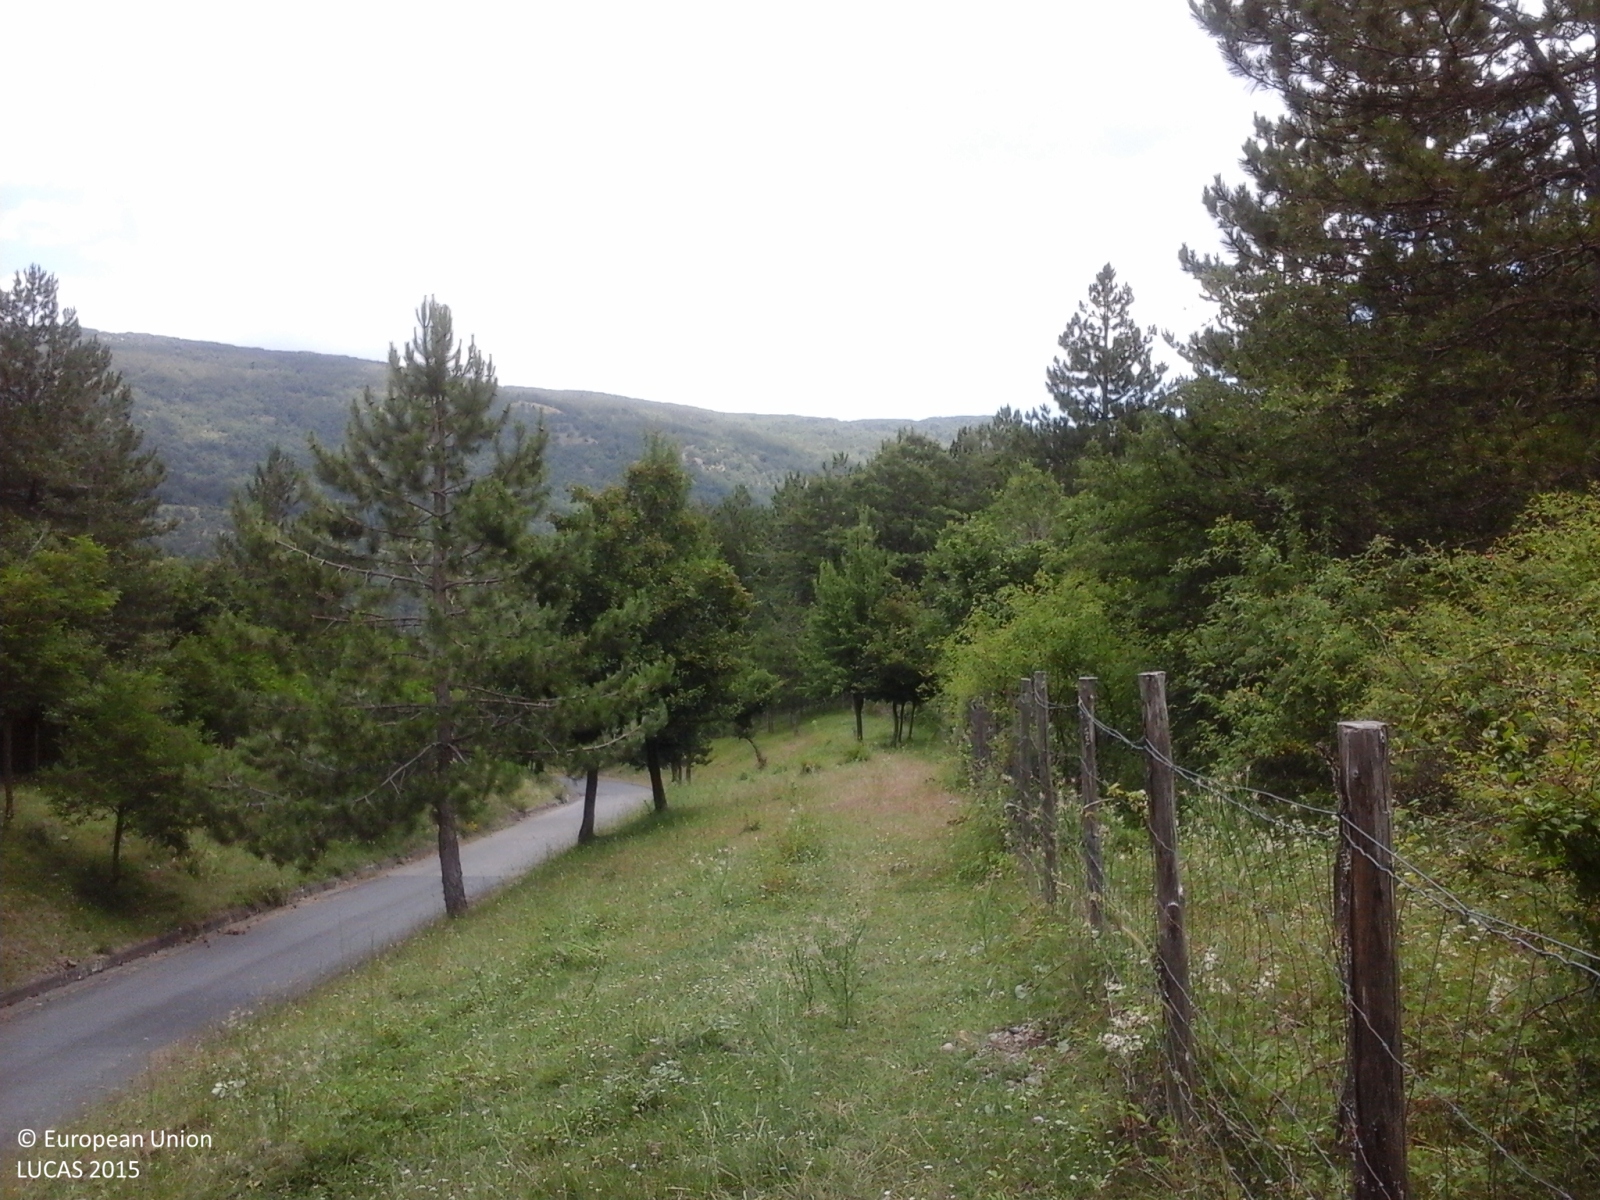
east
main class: Woodland
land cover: Broadleaved woodland
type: thermophilous deciduous forest
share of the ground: > 75 %
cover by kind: broadleaved forest trees 75 %, shrubs 15 %, herbaceous plants 10 %
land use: Amenities, museums, leisure
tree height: > 5 m
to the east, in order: Broadleaved woodland
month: July
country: IT
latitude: 37.9329
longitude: 14.8481
